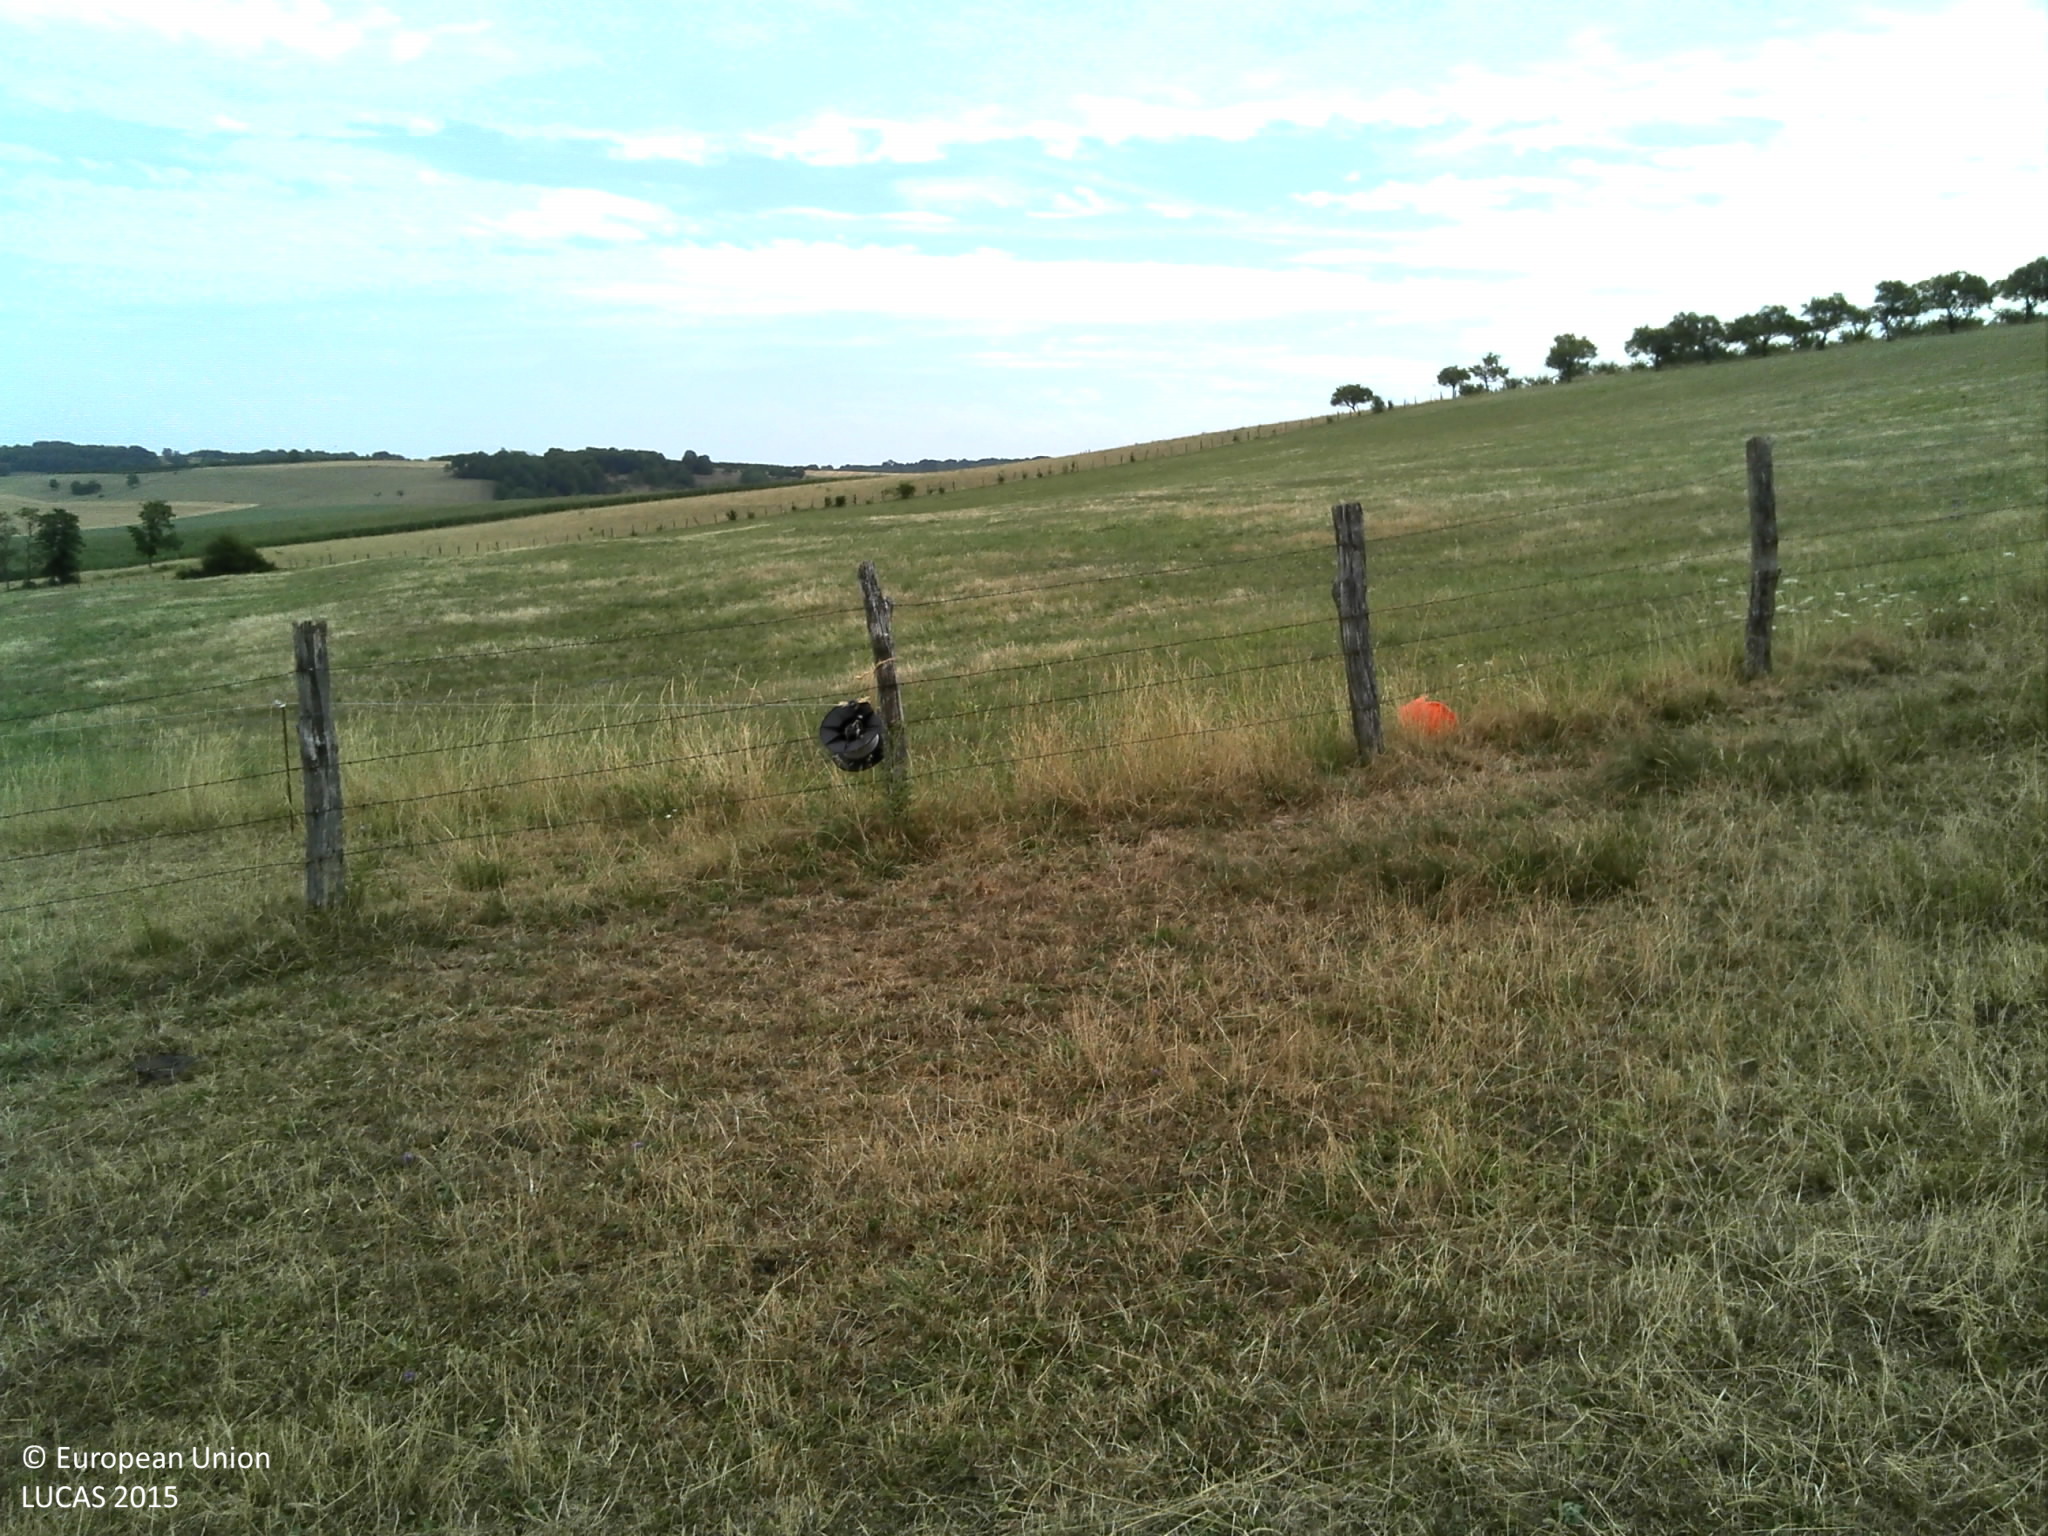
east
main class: Grassland
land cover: Grassland without tree/shrub cover
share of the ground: > 75 %
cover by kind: herbaceous plants 100 %
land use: Agriculture (excluding fallow land and kitchen gardens)
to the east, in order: Grassland without tree/shrub cover; Fences; Grassland without tree/shrub cover; Fences; Grassland without tree/shrub cover
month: July
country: FR
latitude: 48.3224
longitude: 6.2646
